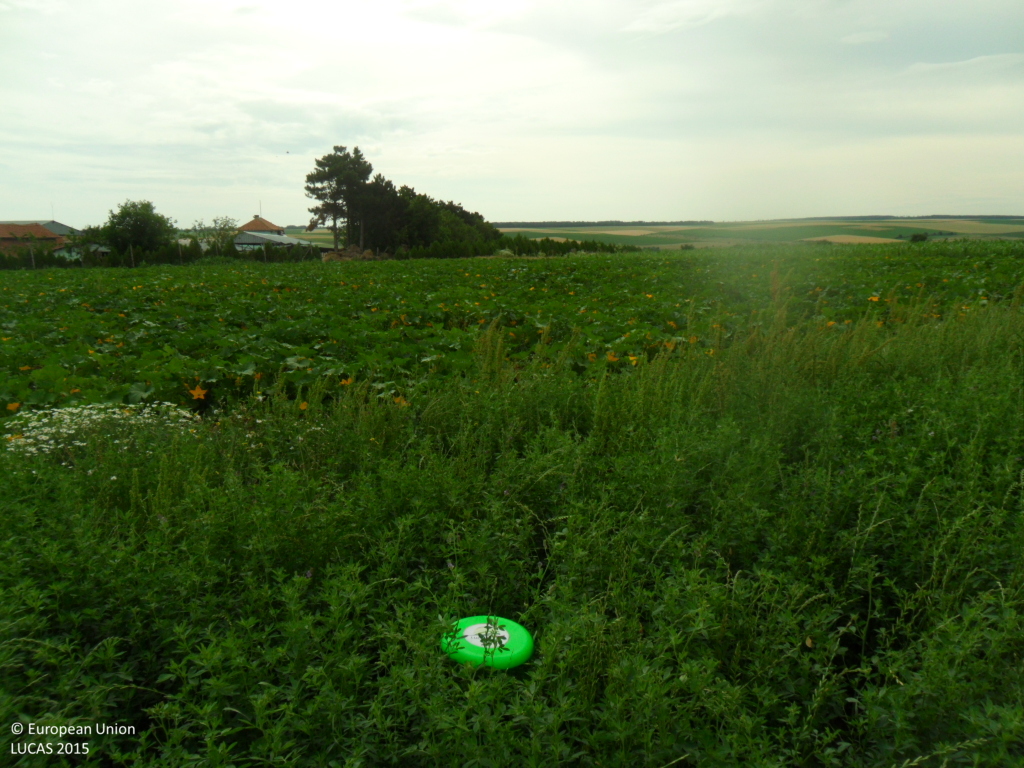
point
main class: Cropland
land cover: Lucerne
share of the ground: > 75 %
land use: Agriculture (excluding fallow land and kitchen gardens)
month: June
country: BG
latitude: 43.7011
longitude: 26.9319
